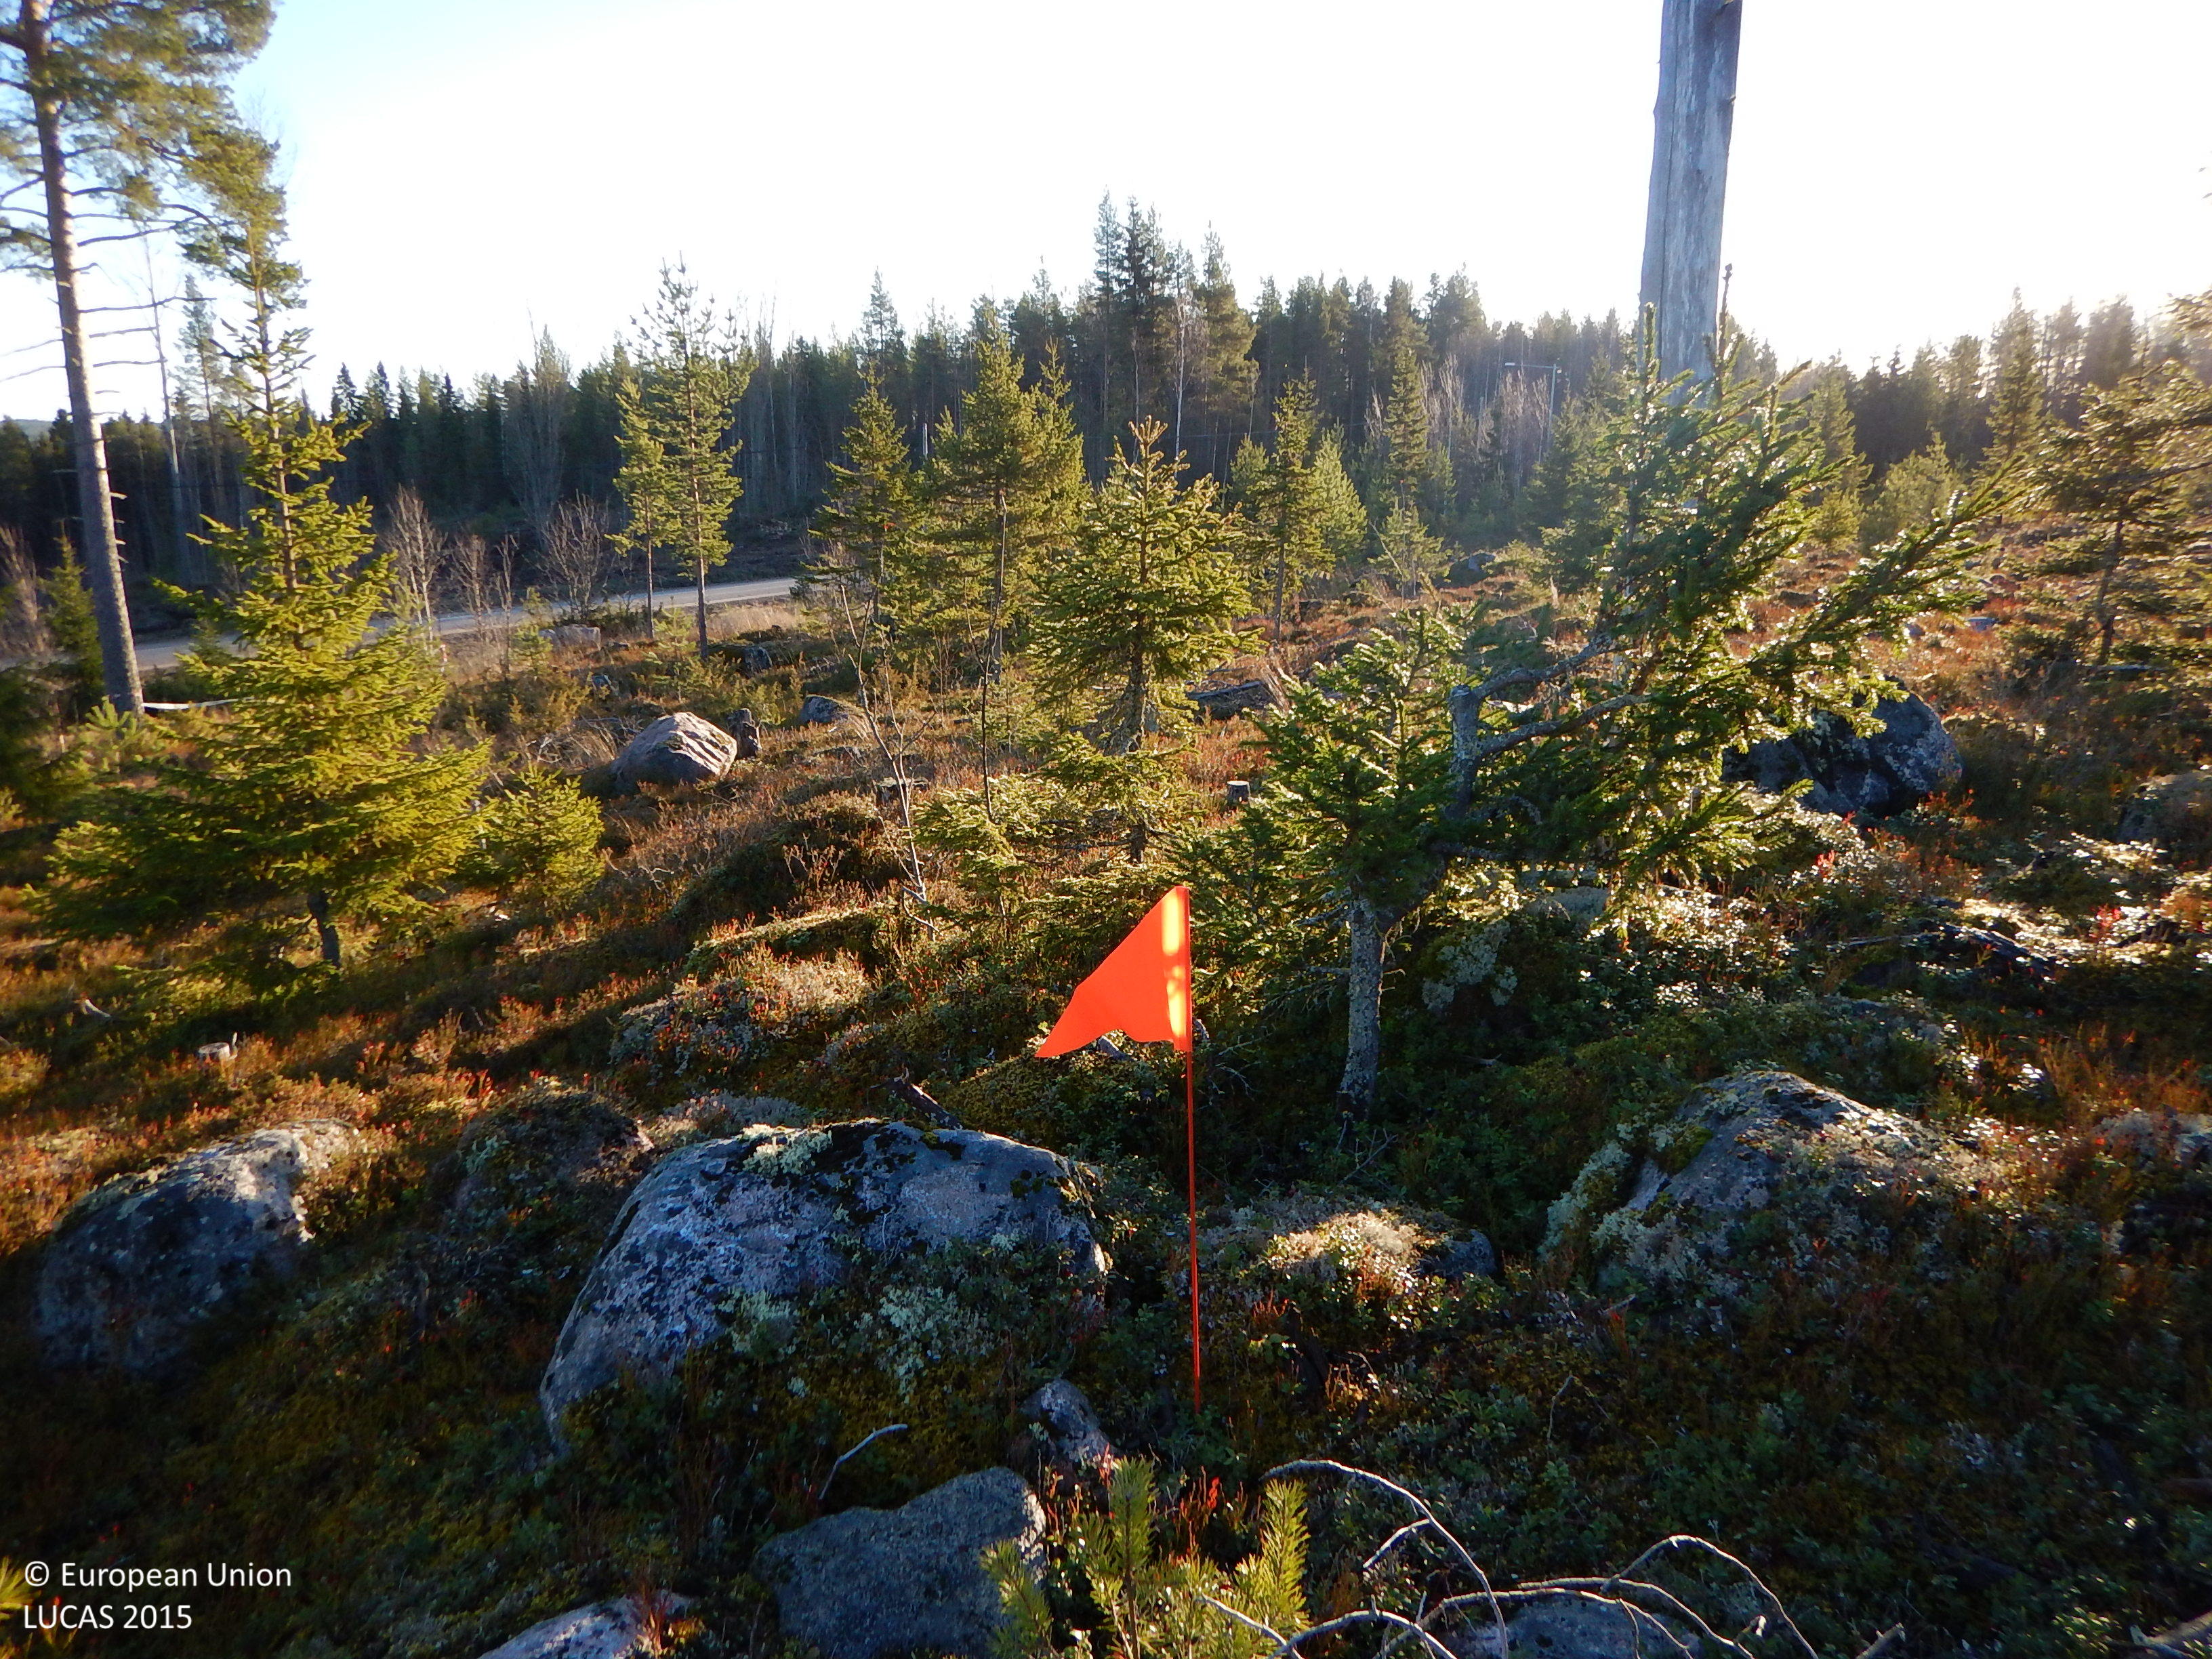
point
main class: Woodland
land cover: Other coniferous woodland
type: boreal forest
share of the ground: 25 - 50 %
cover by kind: coniferous forest trees 30 %, shrubs 30 %, herbaceous plants 20 %, lichens and mosses 20 %
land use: Forestry
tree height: < 5 m
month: November
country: SE
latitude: 65.2966
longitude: 21.2328
